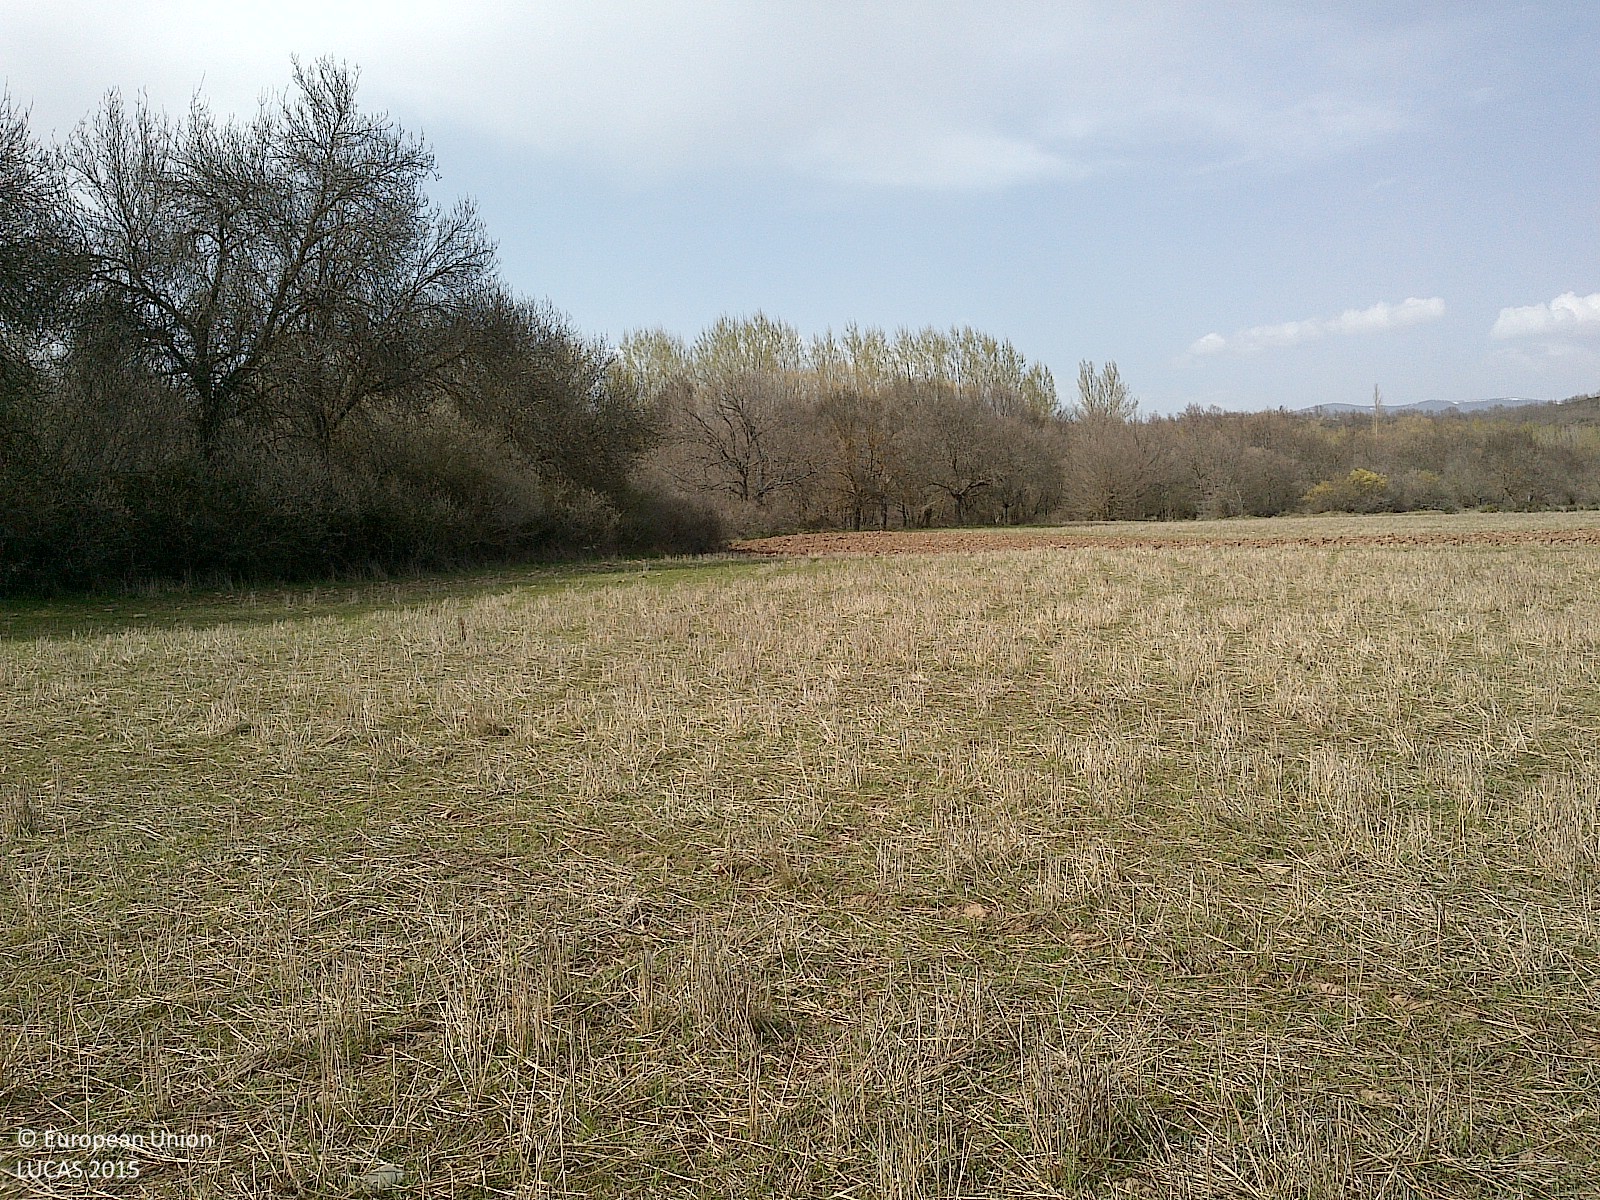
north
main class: Grassland
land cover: Spontaneously vegetated surfaces
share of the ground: 50 - 75 %
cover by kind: herbaceous plants 70 %, unconsolidated bare surface 30 %
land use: Agriculture (excluding fallow land and kitchen gardens)
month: April
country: ES
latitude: 42.0607
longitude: -3.3327
